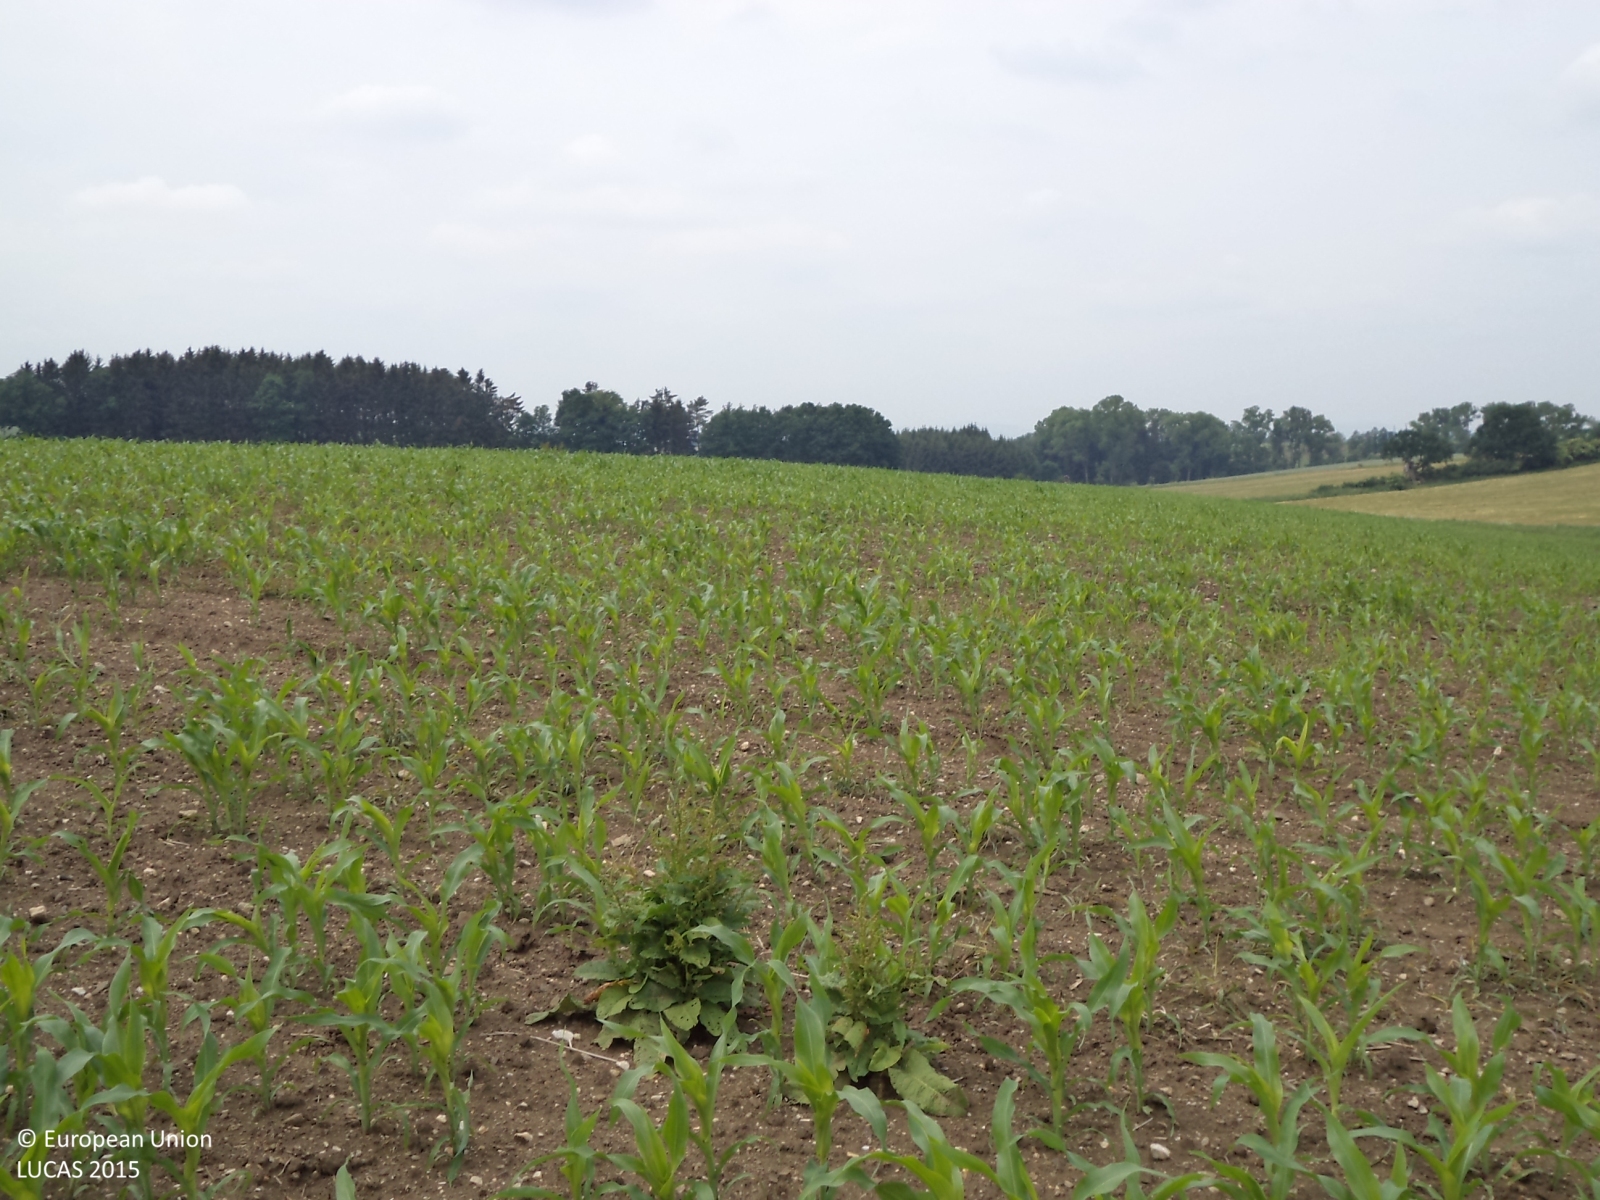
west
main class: Cropland
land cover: Maize
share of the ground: 25 - 50 %
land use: Agriculture (excluding fallow land and kitchen gardens)
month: June
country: CZ
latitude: 49.1088
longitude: 14.3984
